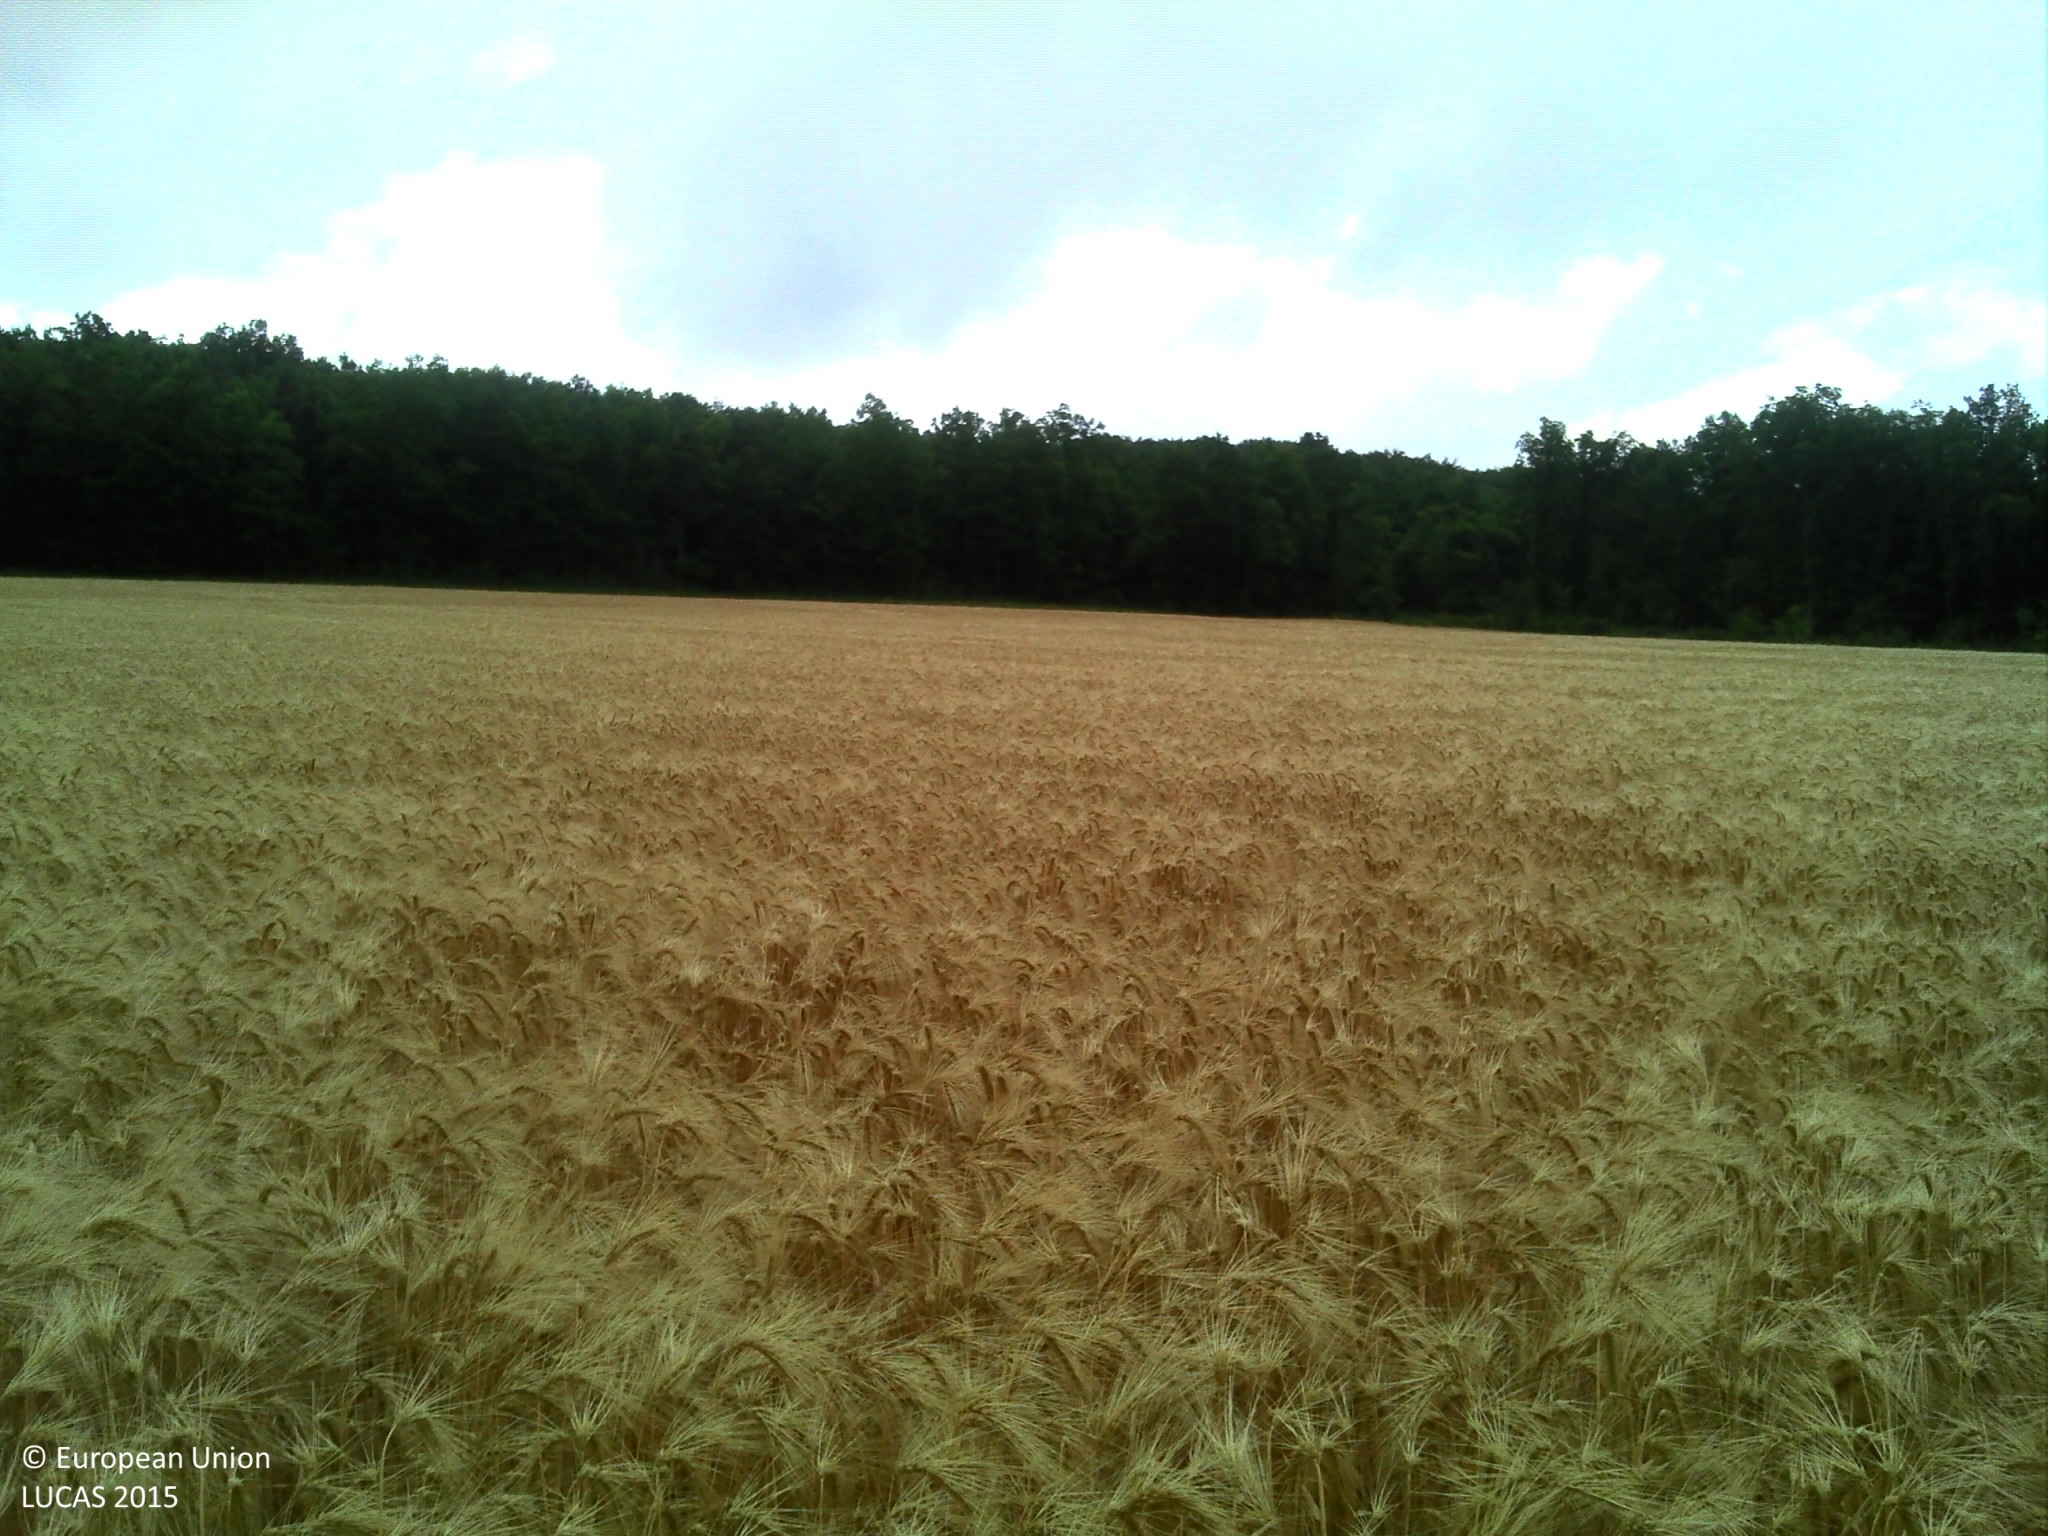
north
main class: Cropland
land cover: Barley
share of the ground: > 75 %
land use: Agriculture (excluding fallow land and kitchen gardens)
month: June
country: FR
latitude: 48.3194
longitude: 3.4806
